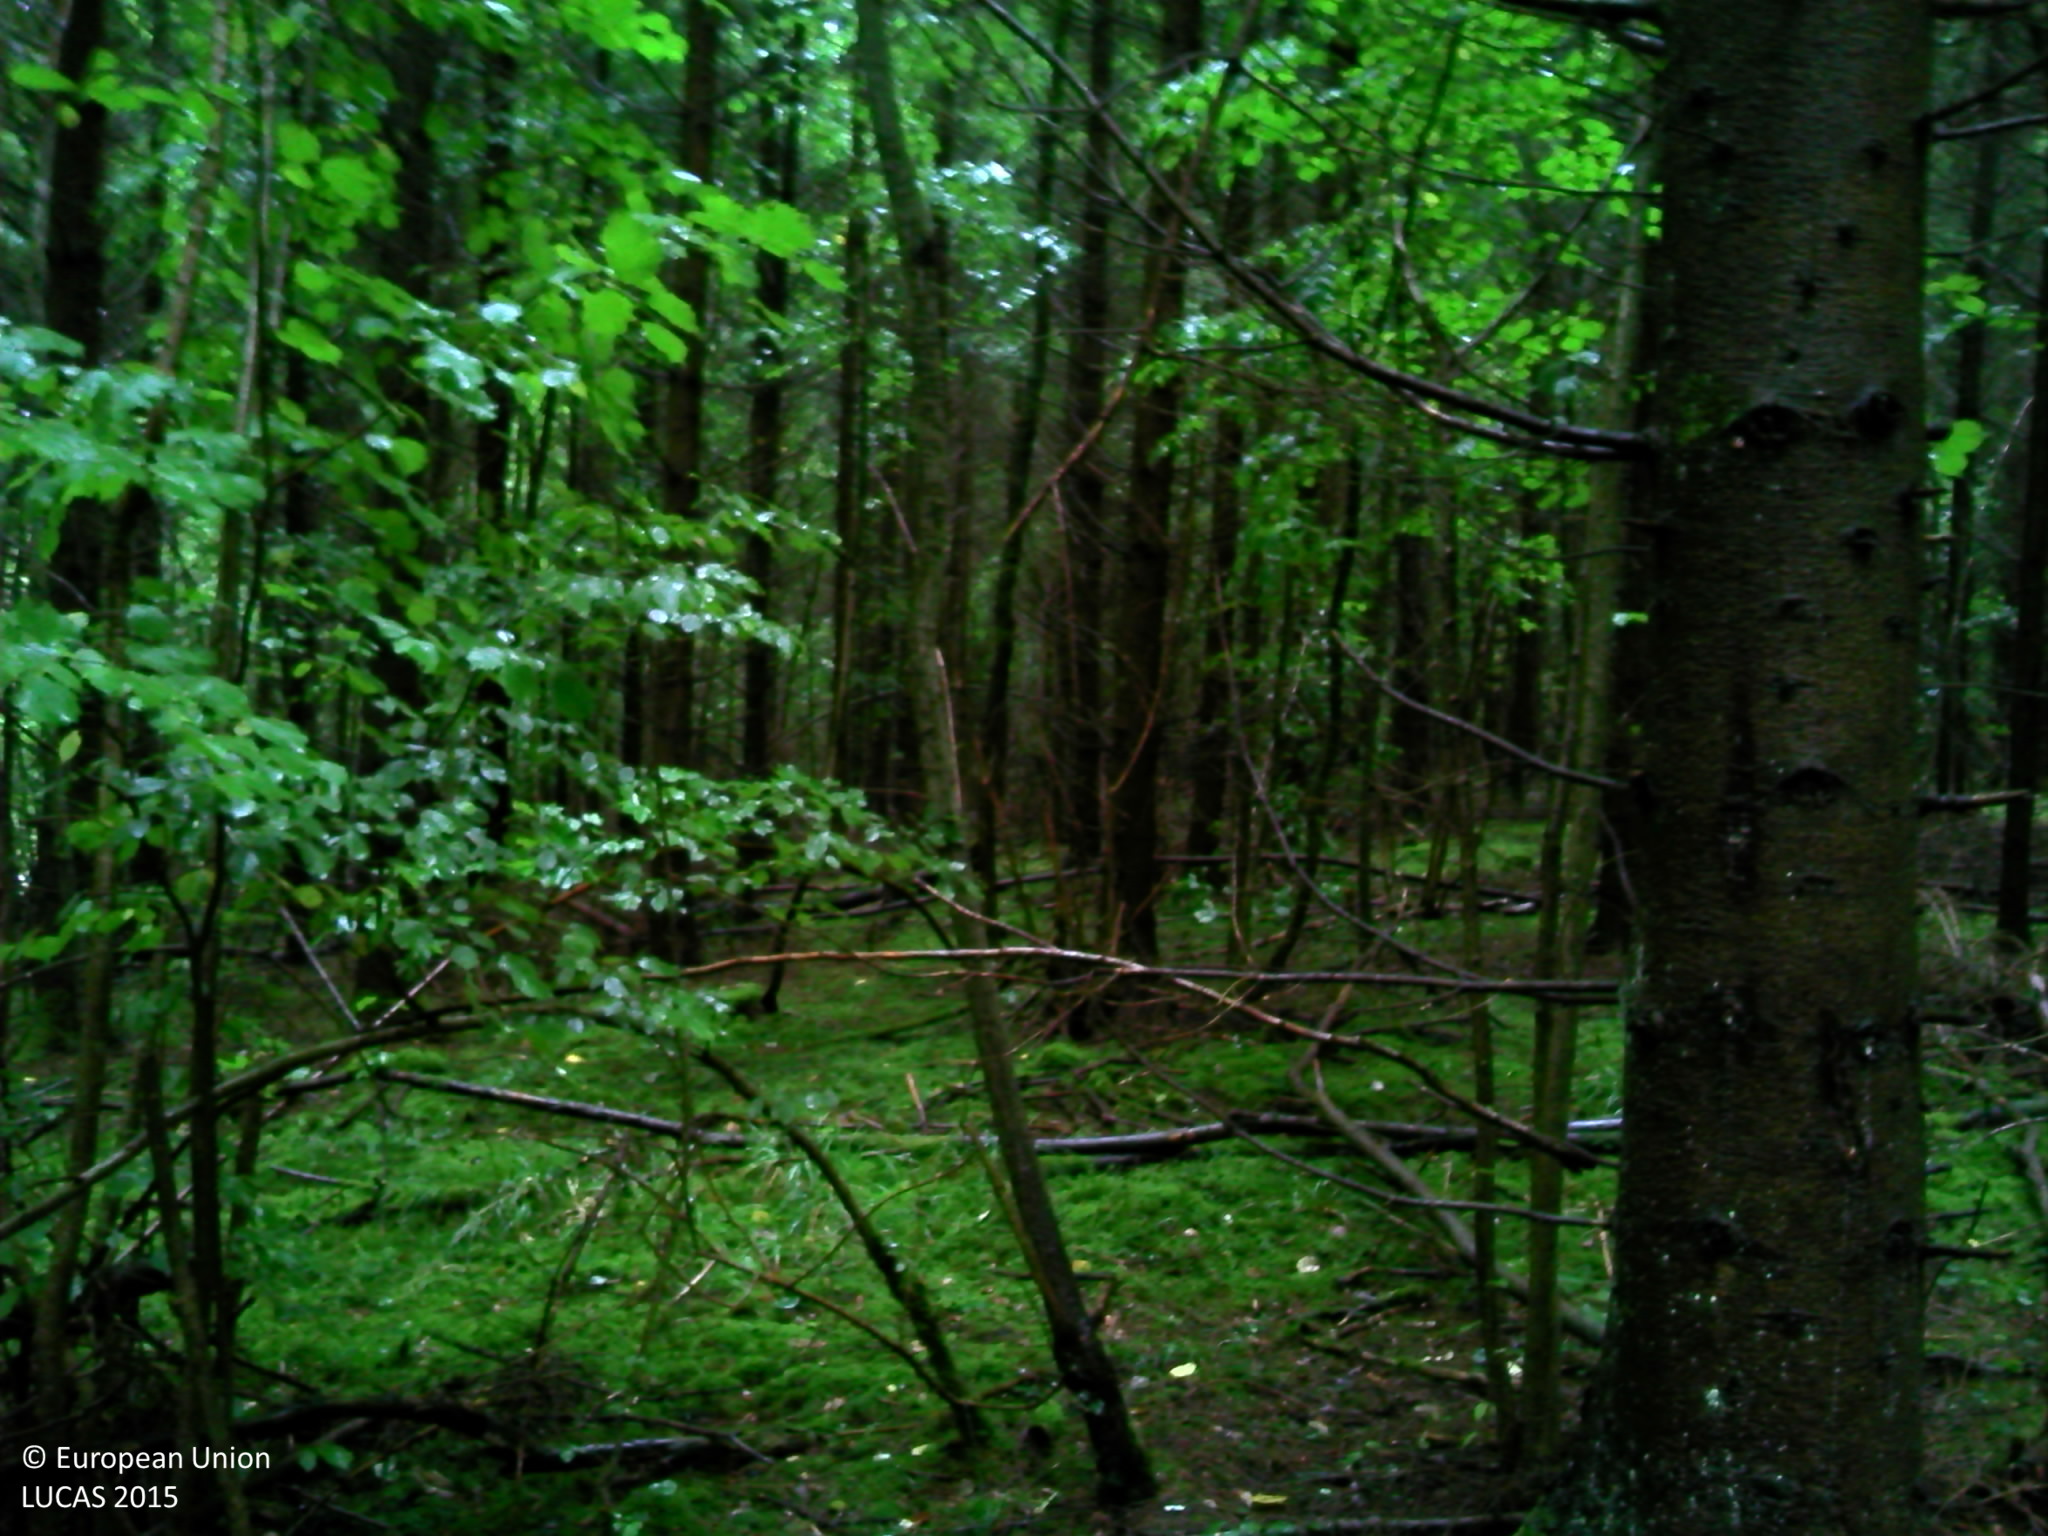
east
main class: Woodland
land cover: Spruce dominated mixed woodland
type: exotic forest
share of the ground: > 75 %
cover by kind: coniferous forest trees 60 %, broadleaved forest trees 30 %, consolidated bare surface 10 %
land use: Forestry
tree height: > 5 m
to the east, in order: Spruce dominated mixed woodland; Tracks; Spruce dominated mixed woodland; Grass margins; Spruce dominated mixed woodland; Tracks; Spruce dominated mixed woodland; Grass margins; Paved roads, cycling and walking lanes; Grassland without tree/shrub cover; Broadleaved woodland
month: September
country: FR
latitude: 48.7130
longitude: 6.0994
